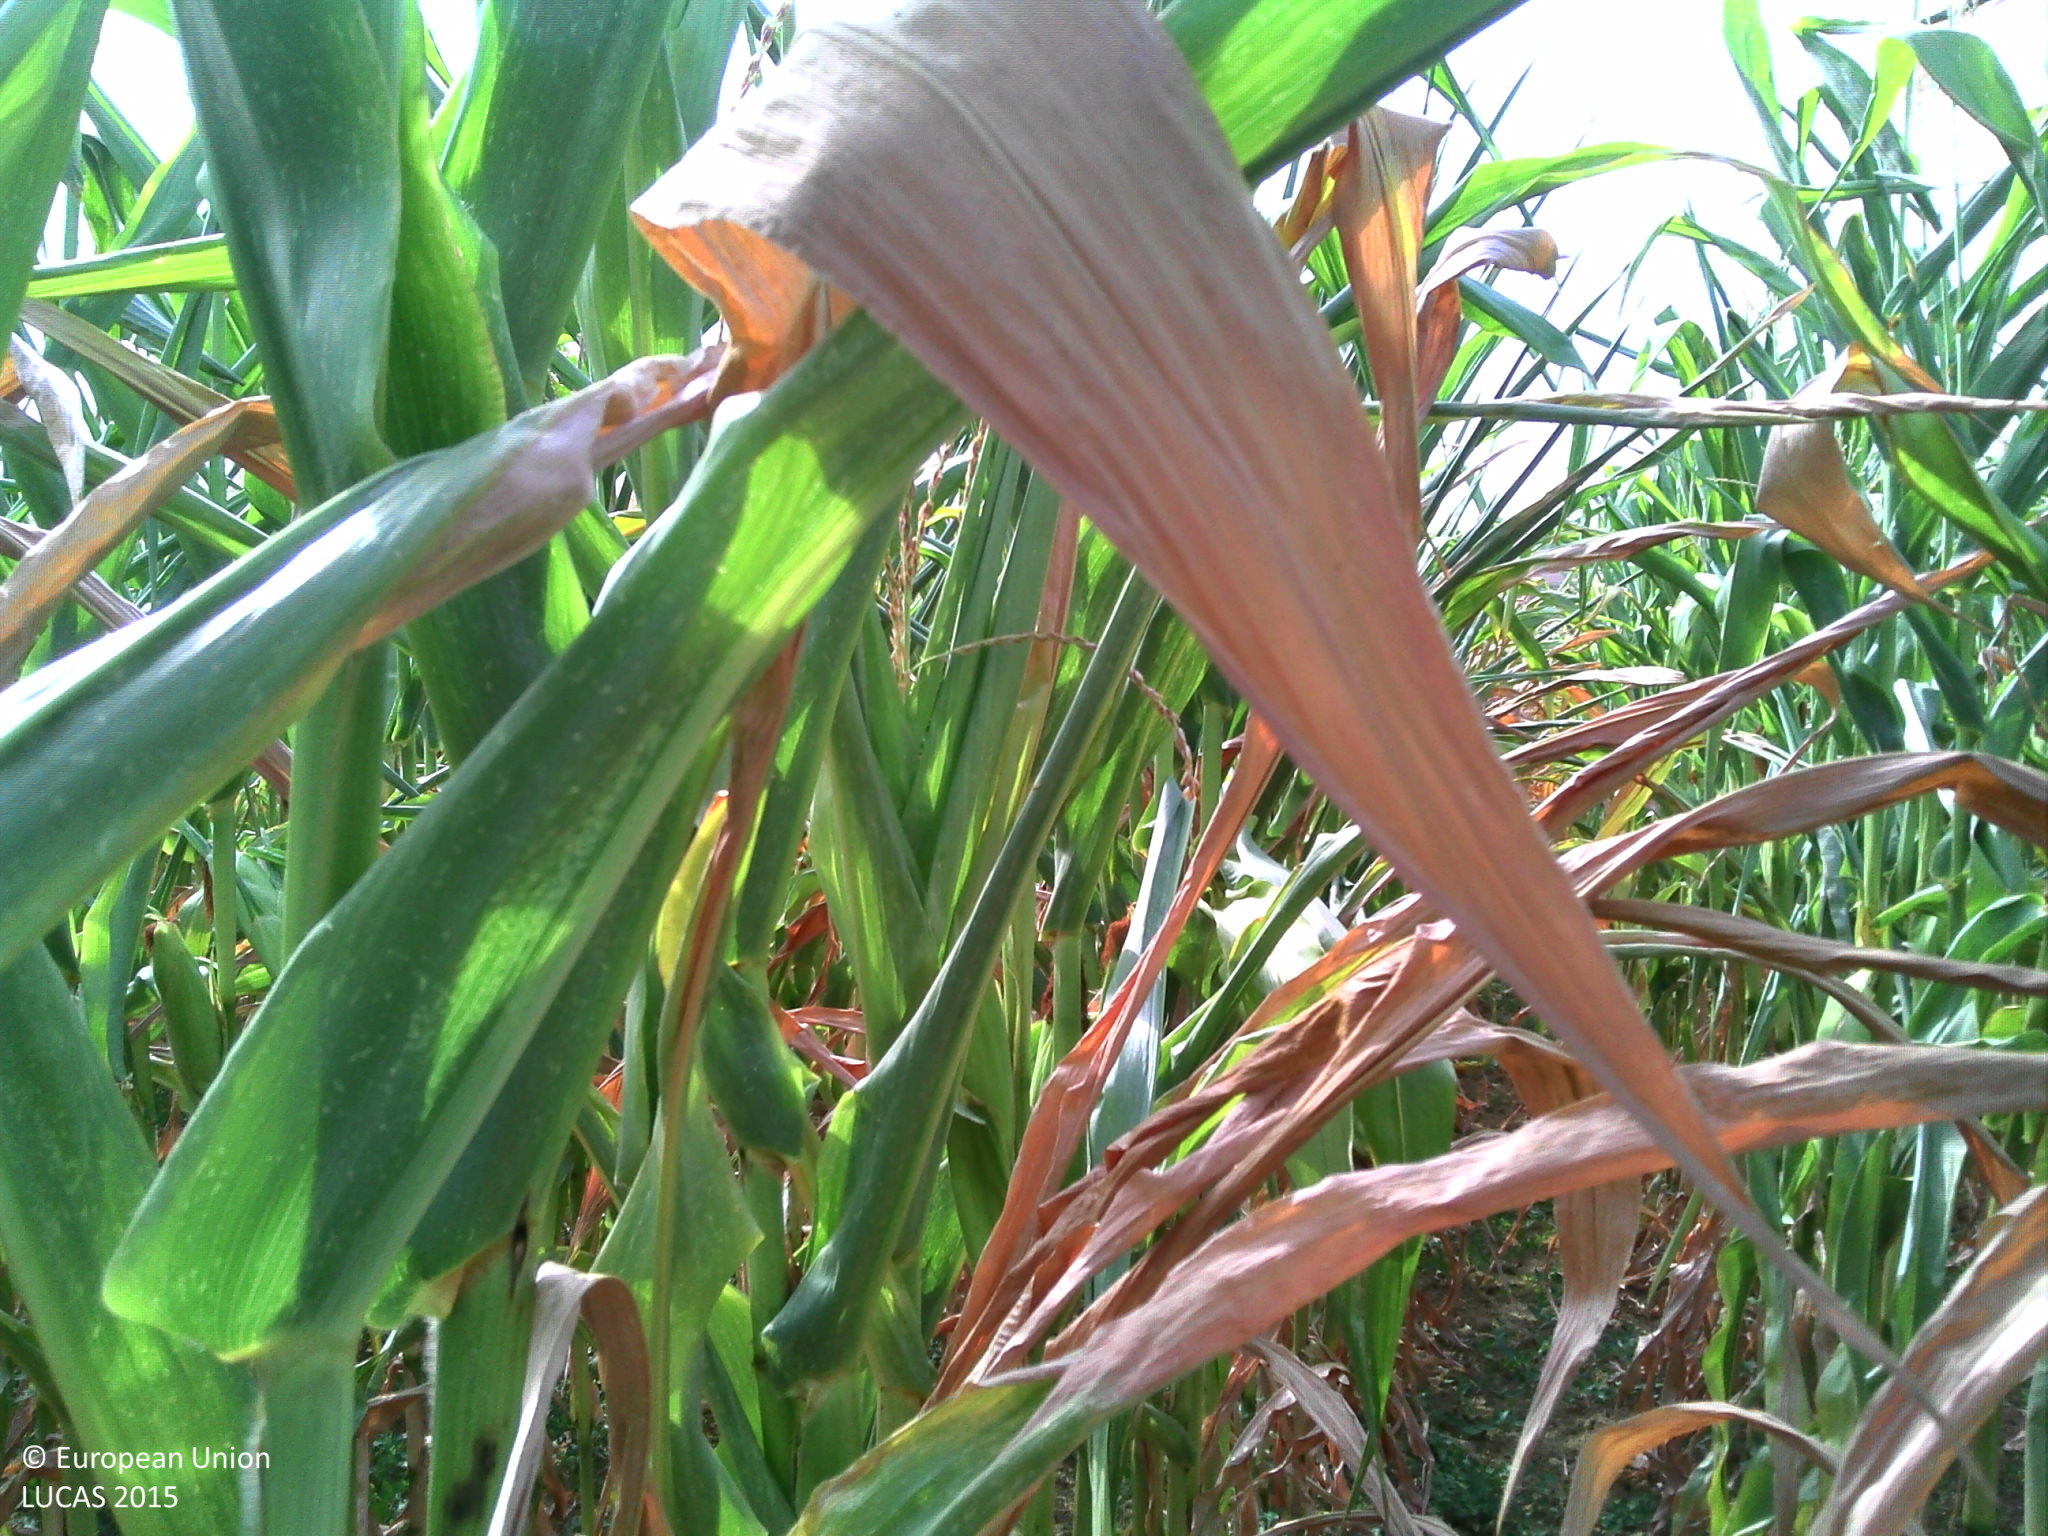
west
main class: Cropland
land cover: Maize
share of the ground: 50 - 75 %
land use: Agriculture (excluding fallow land and kitchen gardens)
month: August
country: FR
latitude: 44.5593
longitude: 0.6133
